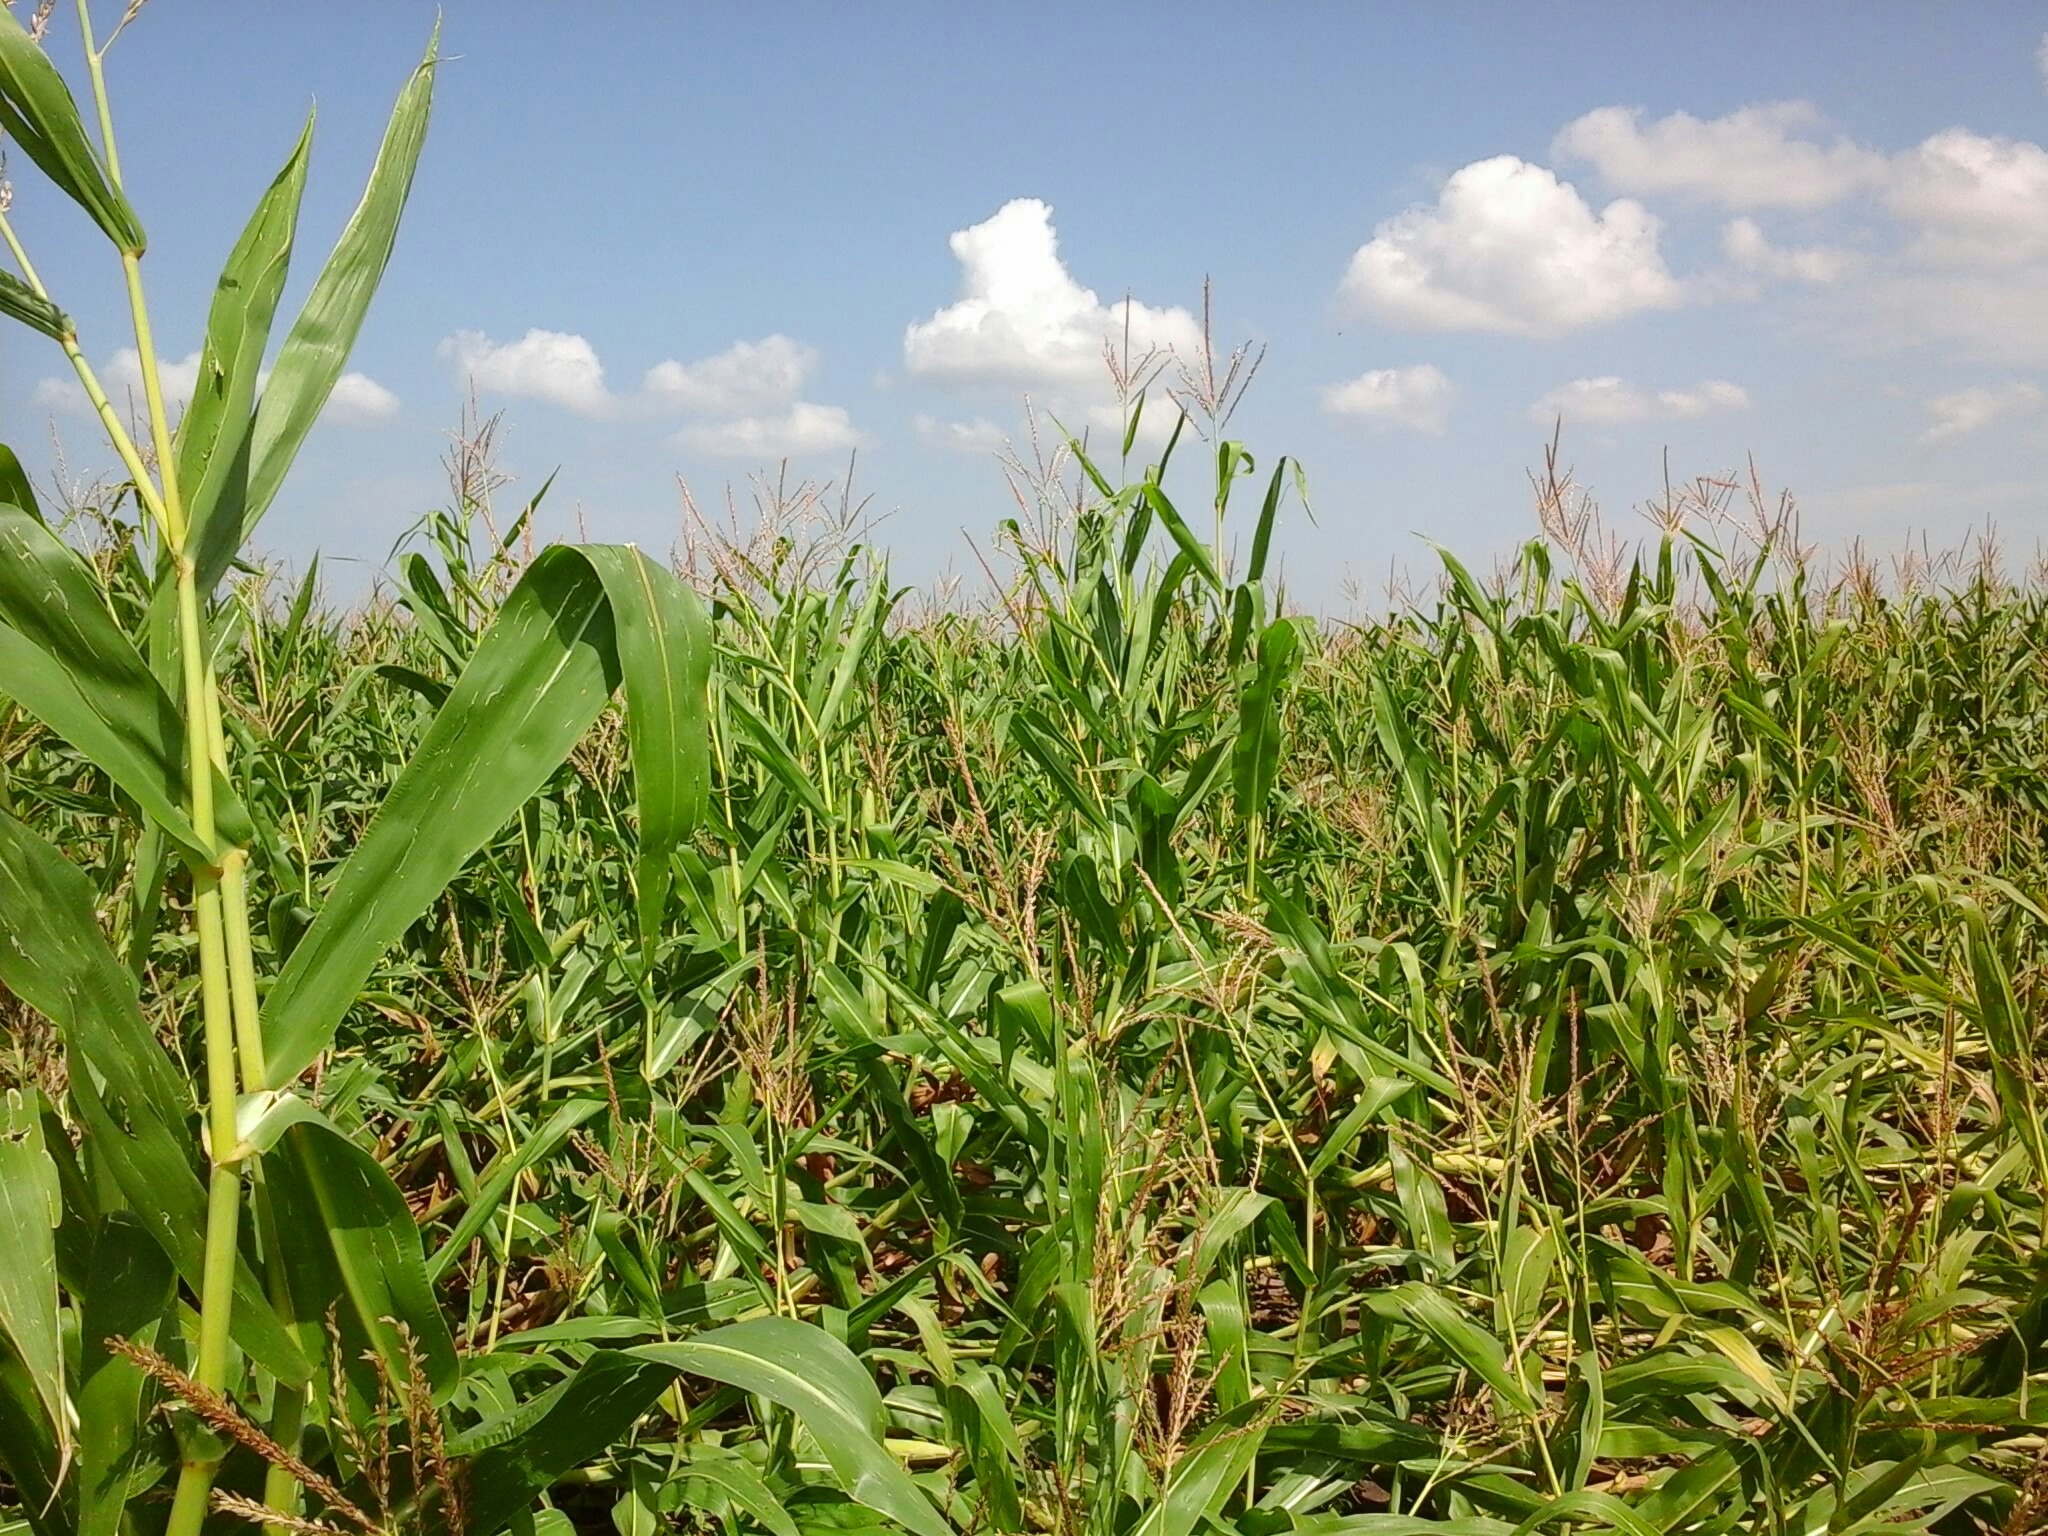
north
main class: Cropland
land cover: Maize
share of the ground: > 75 %
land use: Agriculture (excluding fallow land and kitchen gardens)
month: August
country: HU
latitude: 47.6007
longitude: 18.3259
